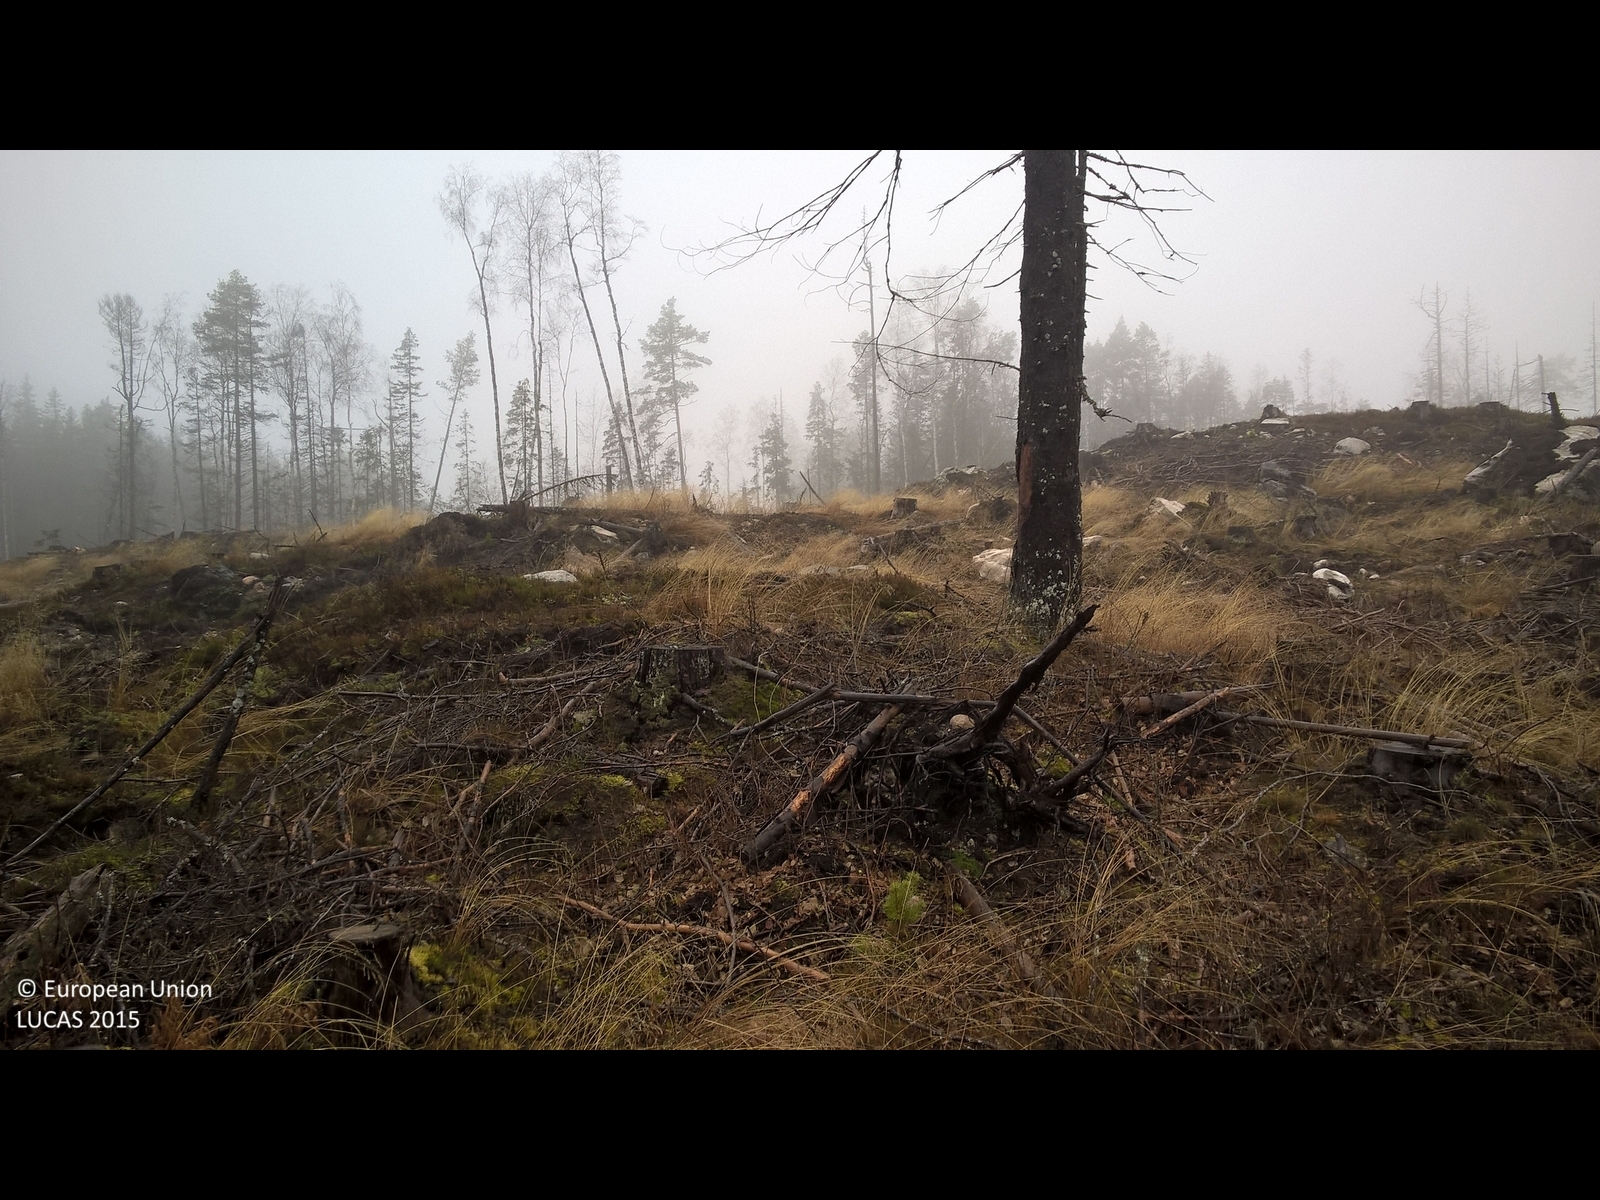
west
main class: Grassland
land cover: Grassland with sparse tree/shrub cover
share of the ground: > 75 %
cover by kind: herbaceous plants 75 %, shrubs 10 %, lichens and mosses 10 %, coniferous forest trees 5 %
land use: Forestry
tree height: > 5 m
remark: Clear cut
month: November
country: SE
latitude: 60.0634
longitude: 14.7858
